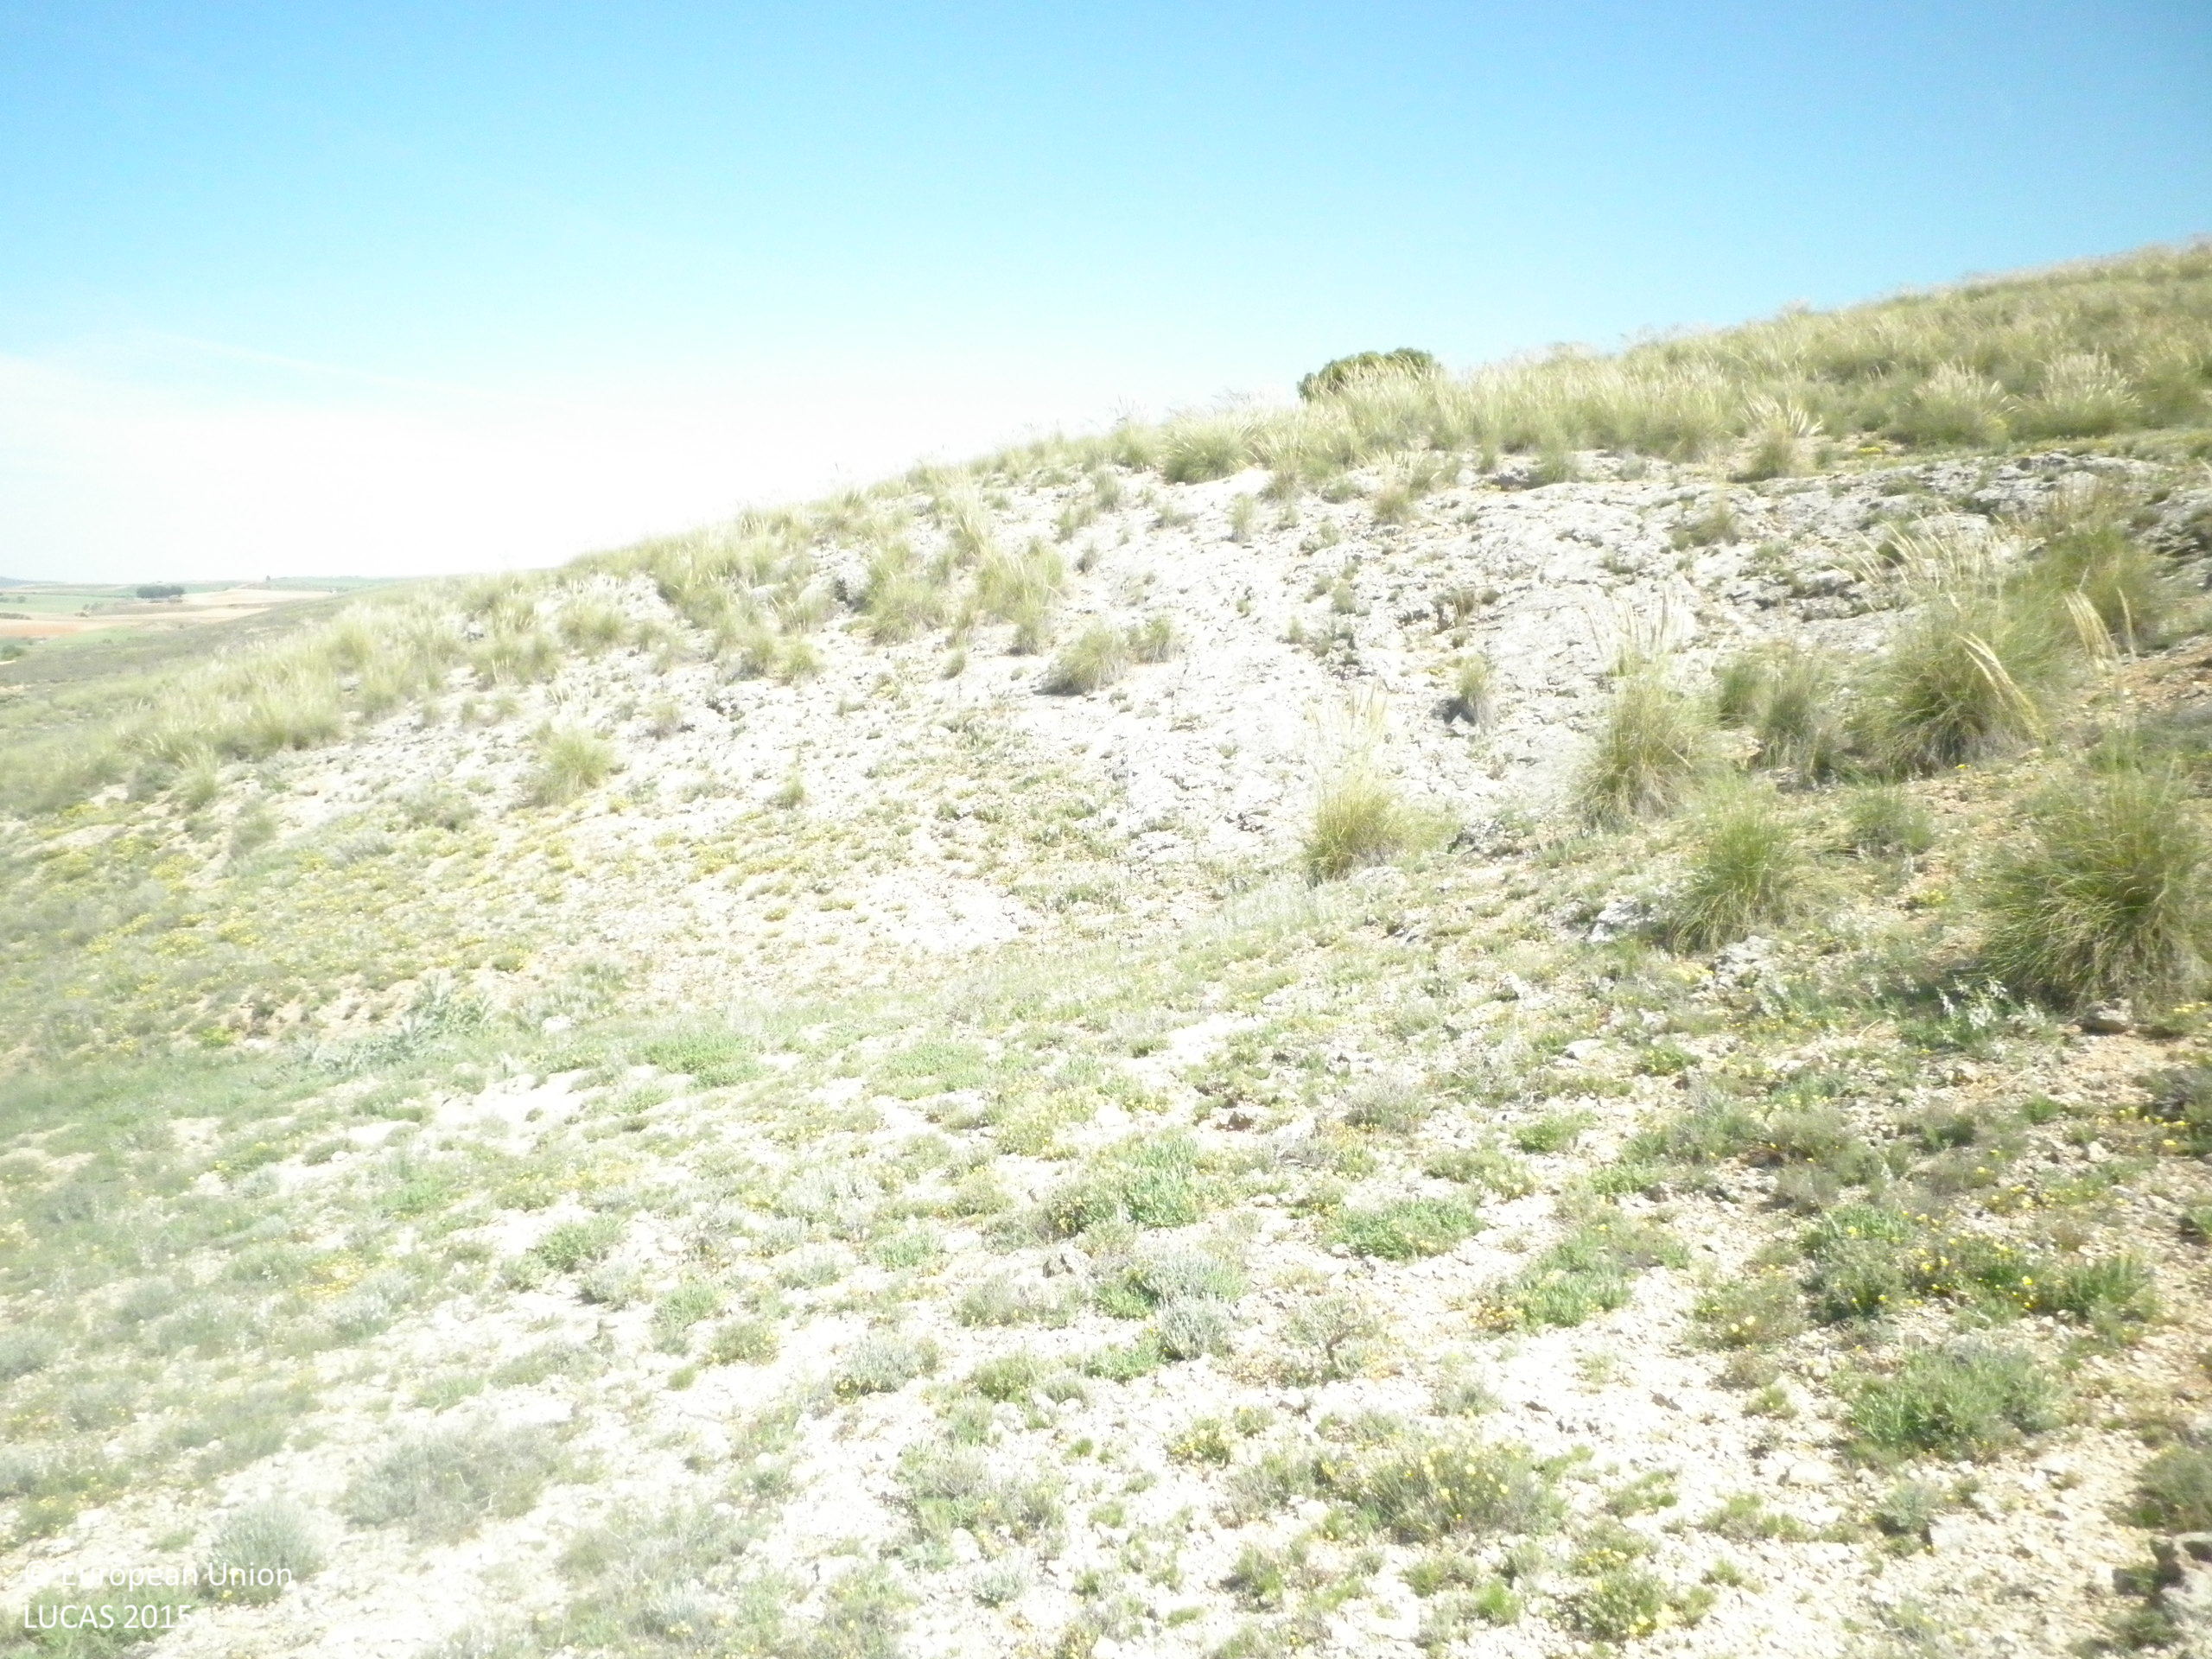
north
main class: Shrubland
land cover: Shrubland without tree cover
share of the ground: > 75 %
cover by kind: unconsolidated bare surface 50 %, herbaceous plants 25 %, shrubs 15 %, consolidated bare surface 10 %
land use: Semi-natural and natural areas not in use
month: May
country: ES
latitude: 39.7072
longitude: -2.7421
